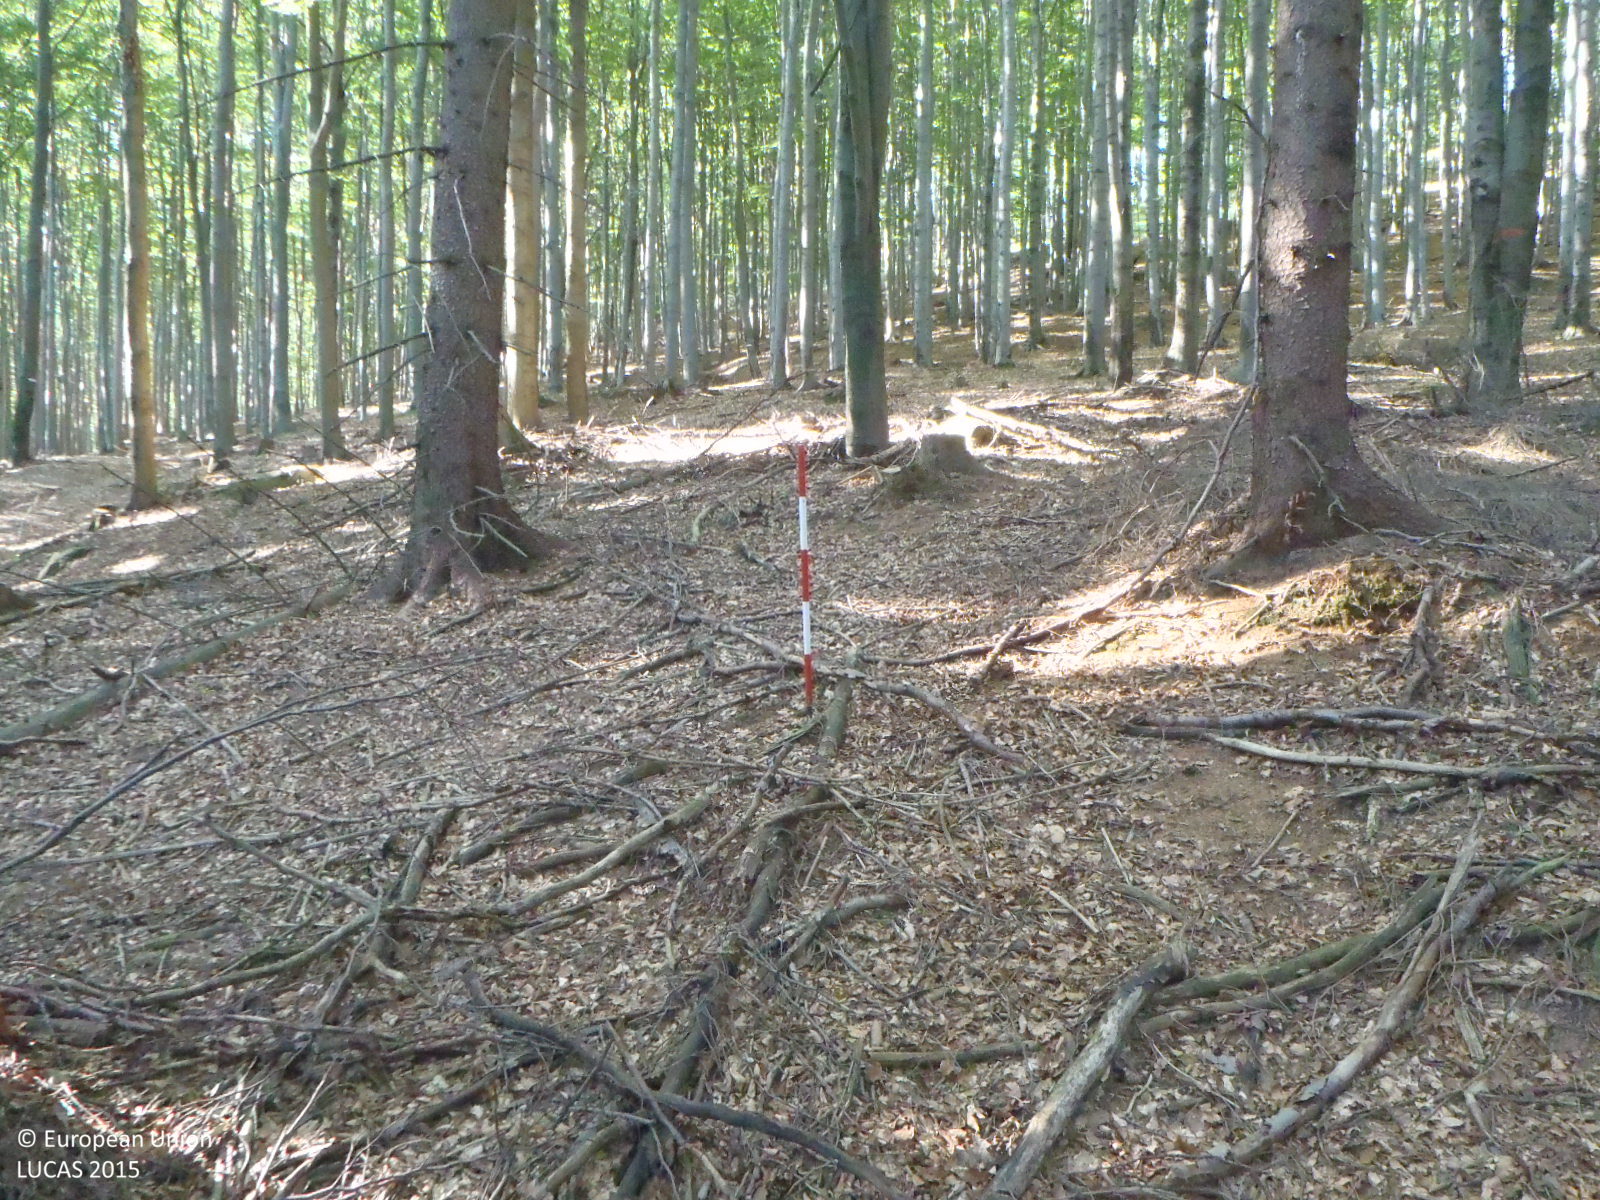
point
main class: Woodland
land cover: Spruce dominated mixed woodland
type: hemiboreal forest and nemoral coniferous forest and mixed broadleaved-coniferous forest
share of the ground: > 75 %
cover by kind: coniferous forest trees 50 %, broadleaved forest trees 50 %
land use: Forestry
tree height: > 5 m
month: August
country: CZ
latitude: 50.8315
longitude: 14.5596
